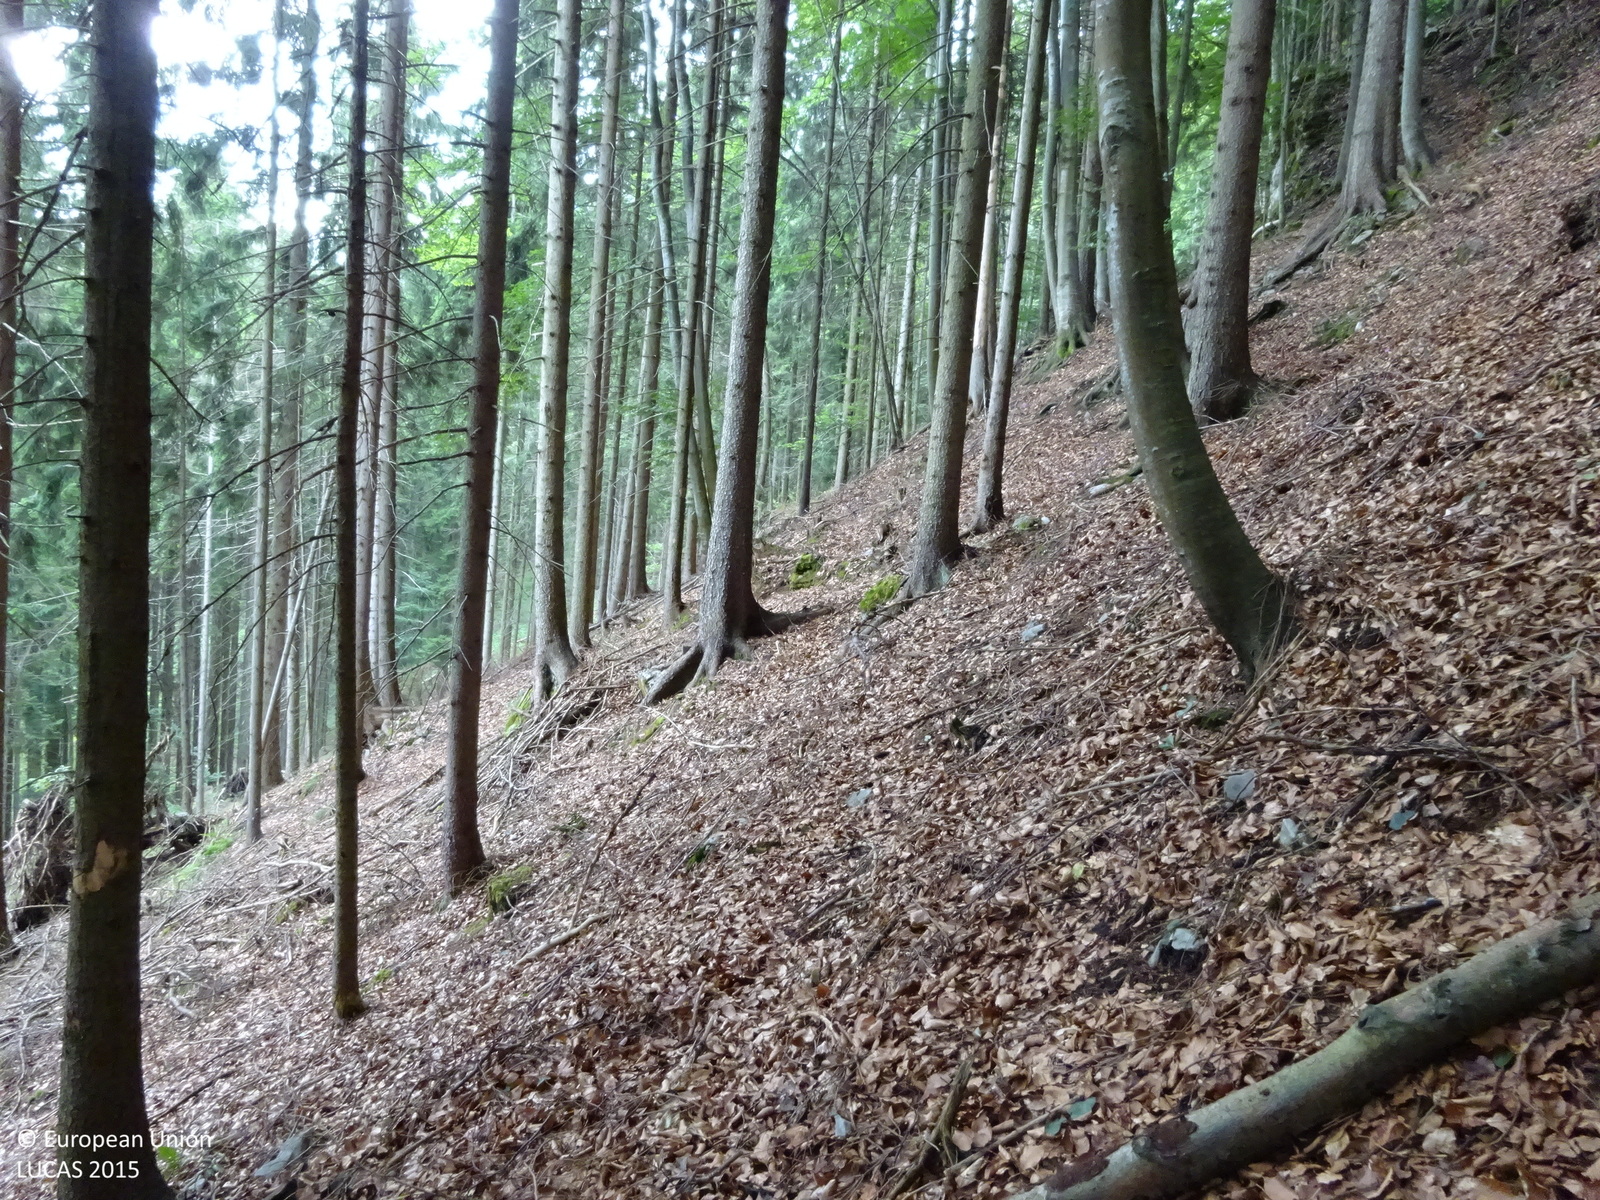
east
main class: Woodland
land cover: Spruce dominated mixed woodland
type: mountainous beech forest
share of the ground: > 75 %
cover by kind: broadleaved forest trees 55 %, coniferous forest trees 35 %, unconsolidated bare surface 10 %
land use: Forestry
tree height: > 5 m
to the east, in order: Spruce dominated mixed woodland; Spruce dominated coniferous woodland; Tracks; Spruce dominated coniferous woodland; Spruce dominated mixed woodland
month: July
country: AT
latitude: 47.2047
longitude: 15.4524
